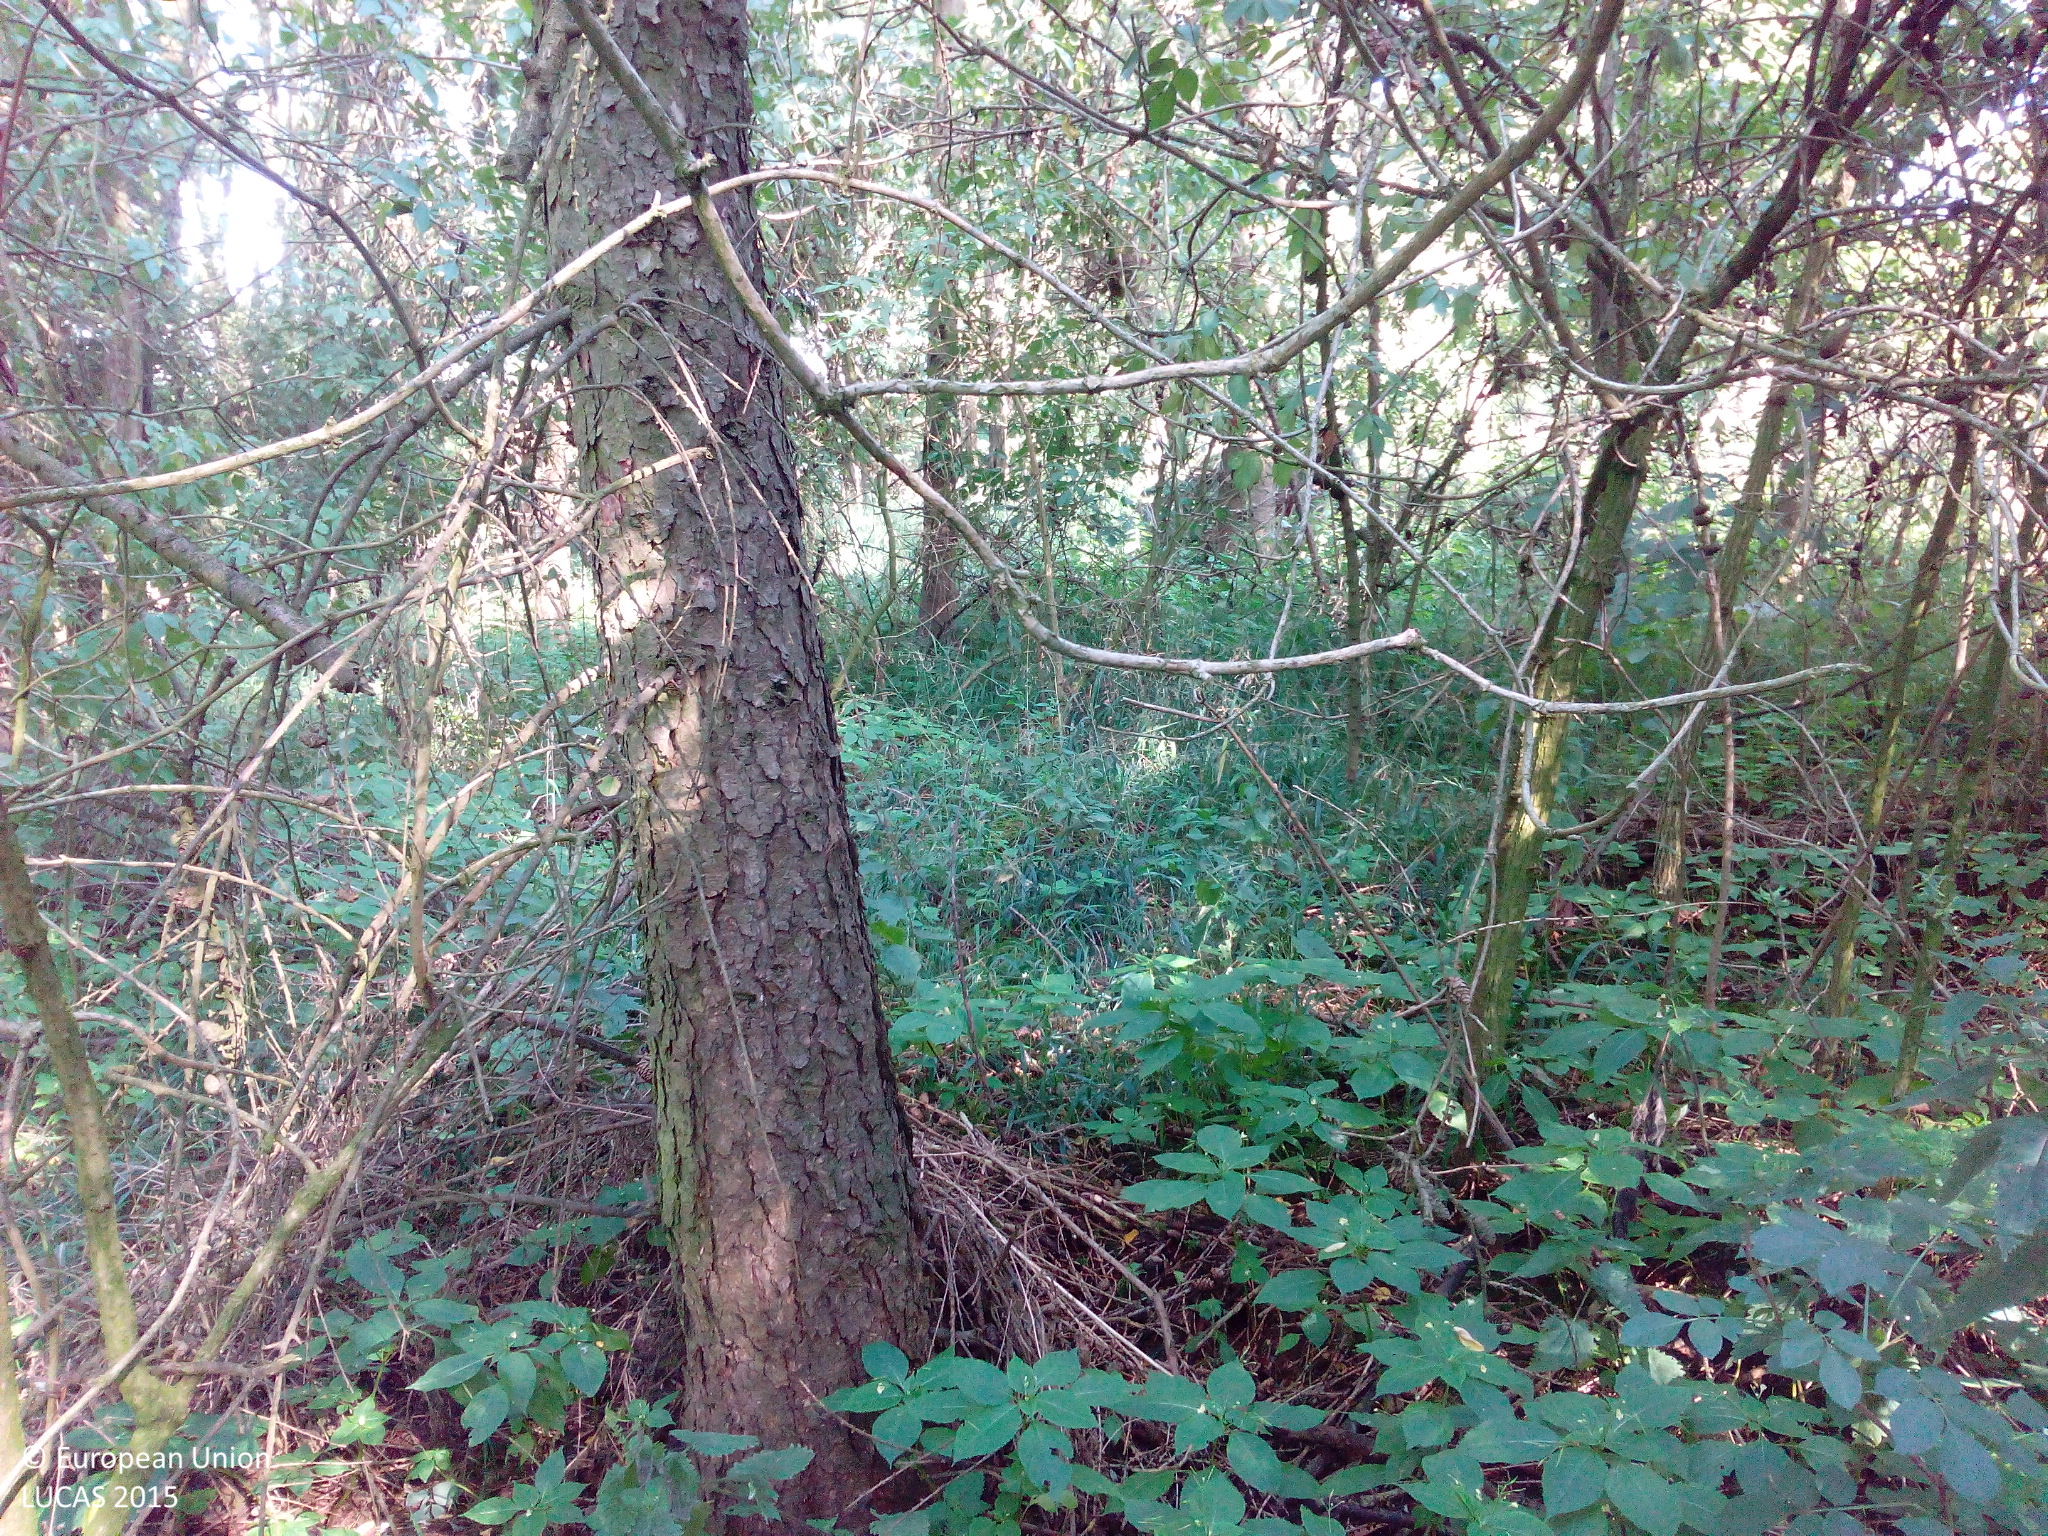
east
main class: Woodland
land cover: Other coniferous woodland
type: hemiboreal forest and nemoral coniferous forest and mixed broadleaved-coniferous forest
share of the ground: > 75 %
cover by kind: coniferous forest trees 75 %, broadleaved forest trees 10 %, shrubs 10 %, herbaceous plants 5 %
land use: Forestry
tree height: > 5 m
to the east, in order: Other coniferous woodland; Other leguminous and mixtures for fodder; Grassland without tree/shrub cover; Tracks; Grassland without tree/shrub cover; Common wheat
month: August
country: DE
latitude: 53.4923
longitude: 13.6023
